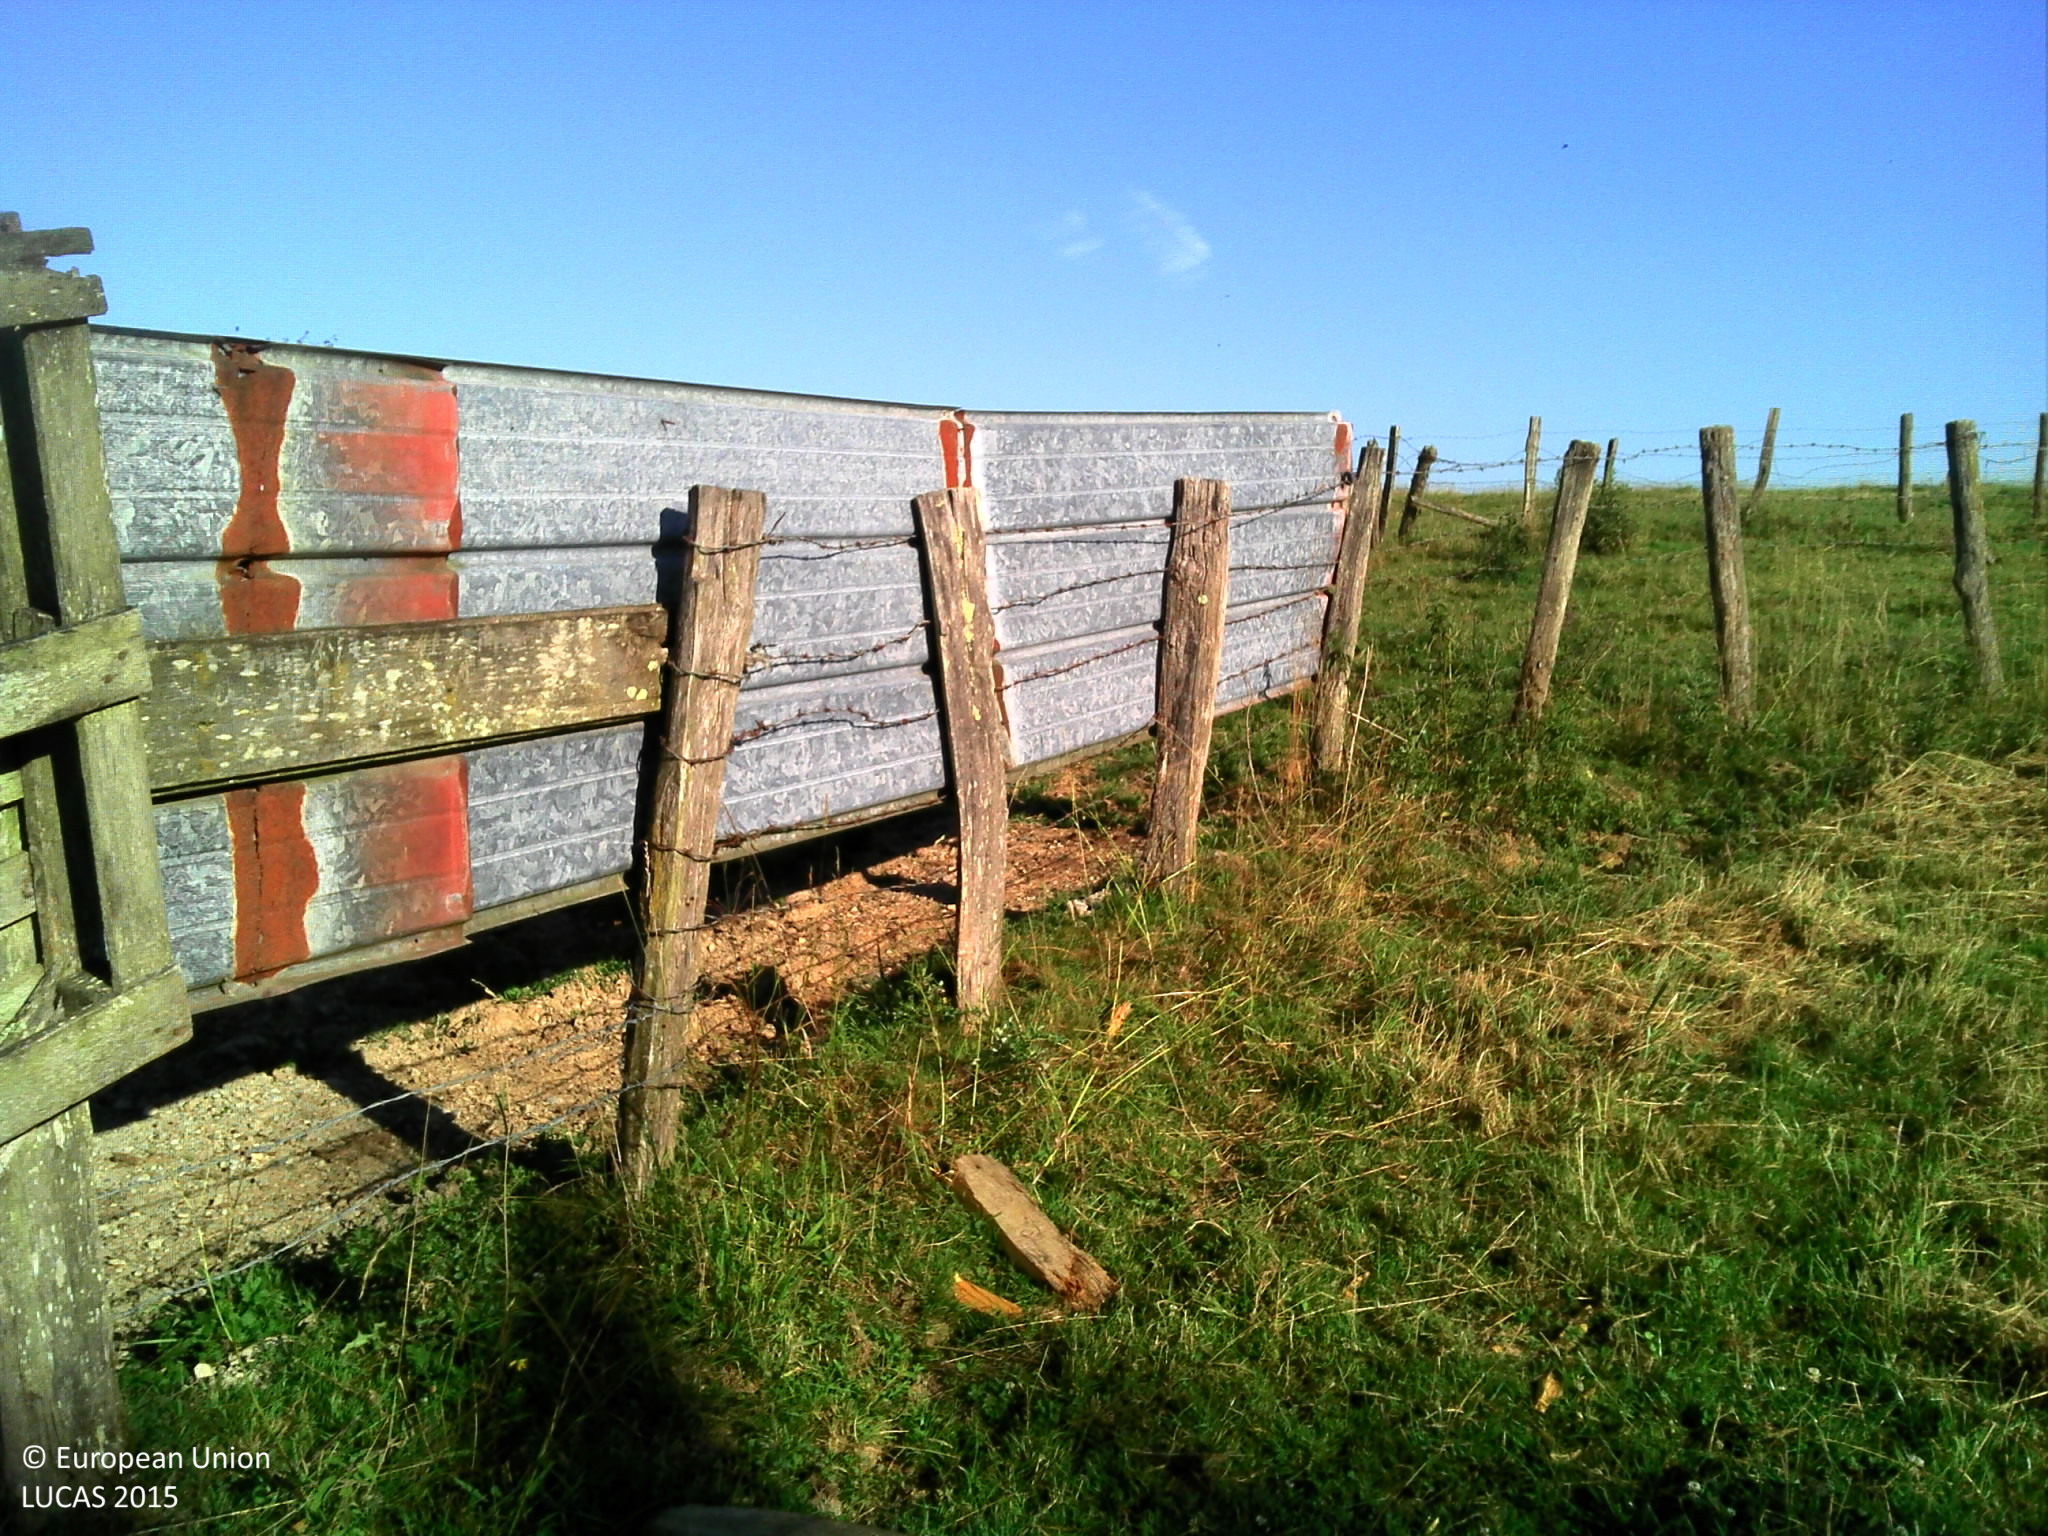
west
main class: Grassland
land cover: Grassland without tree/shrub cover
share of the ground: > 75 %
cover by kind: herbaceous plants 100 %
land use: Agriculture (excluding fallow land and kitchen gardens)
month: June
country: FR
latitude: 47.3606
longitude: 6.0692
